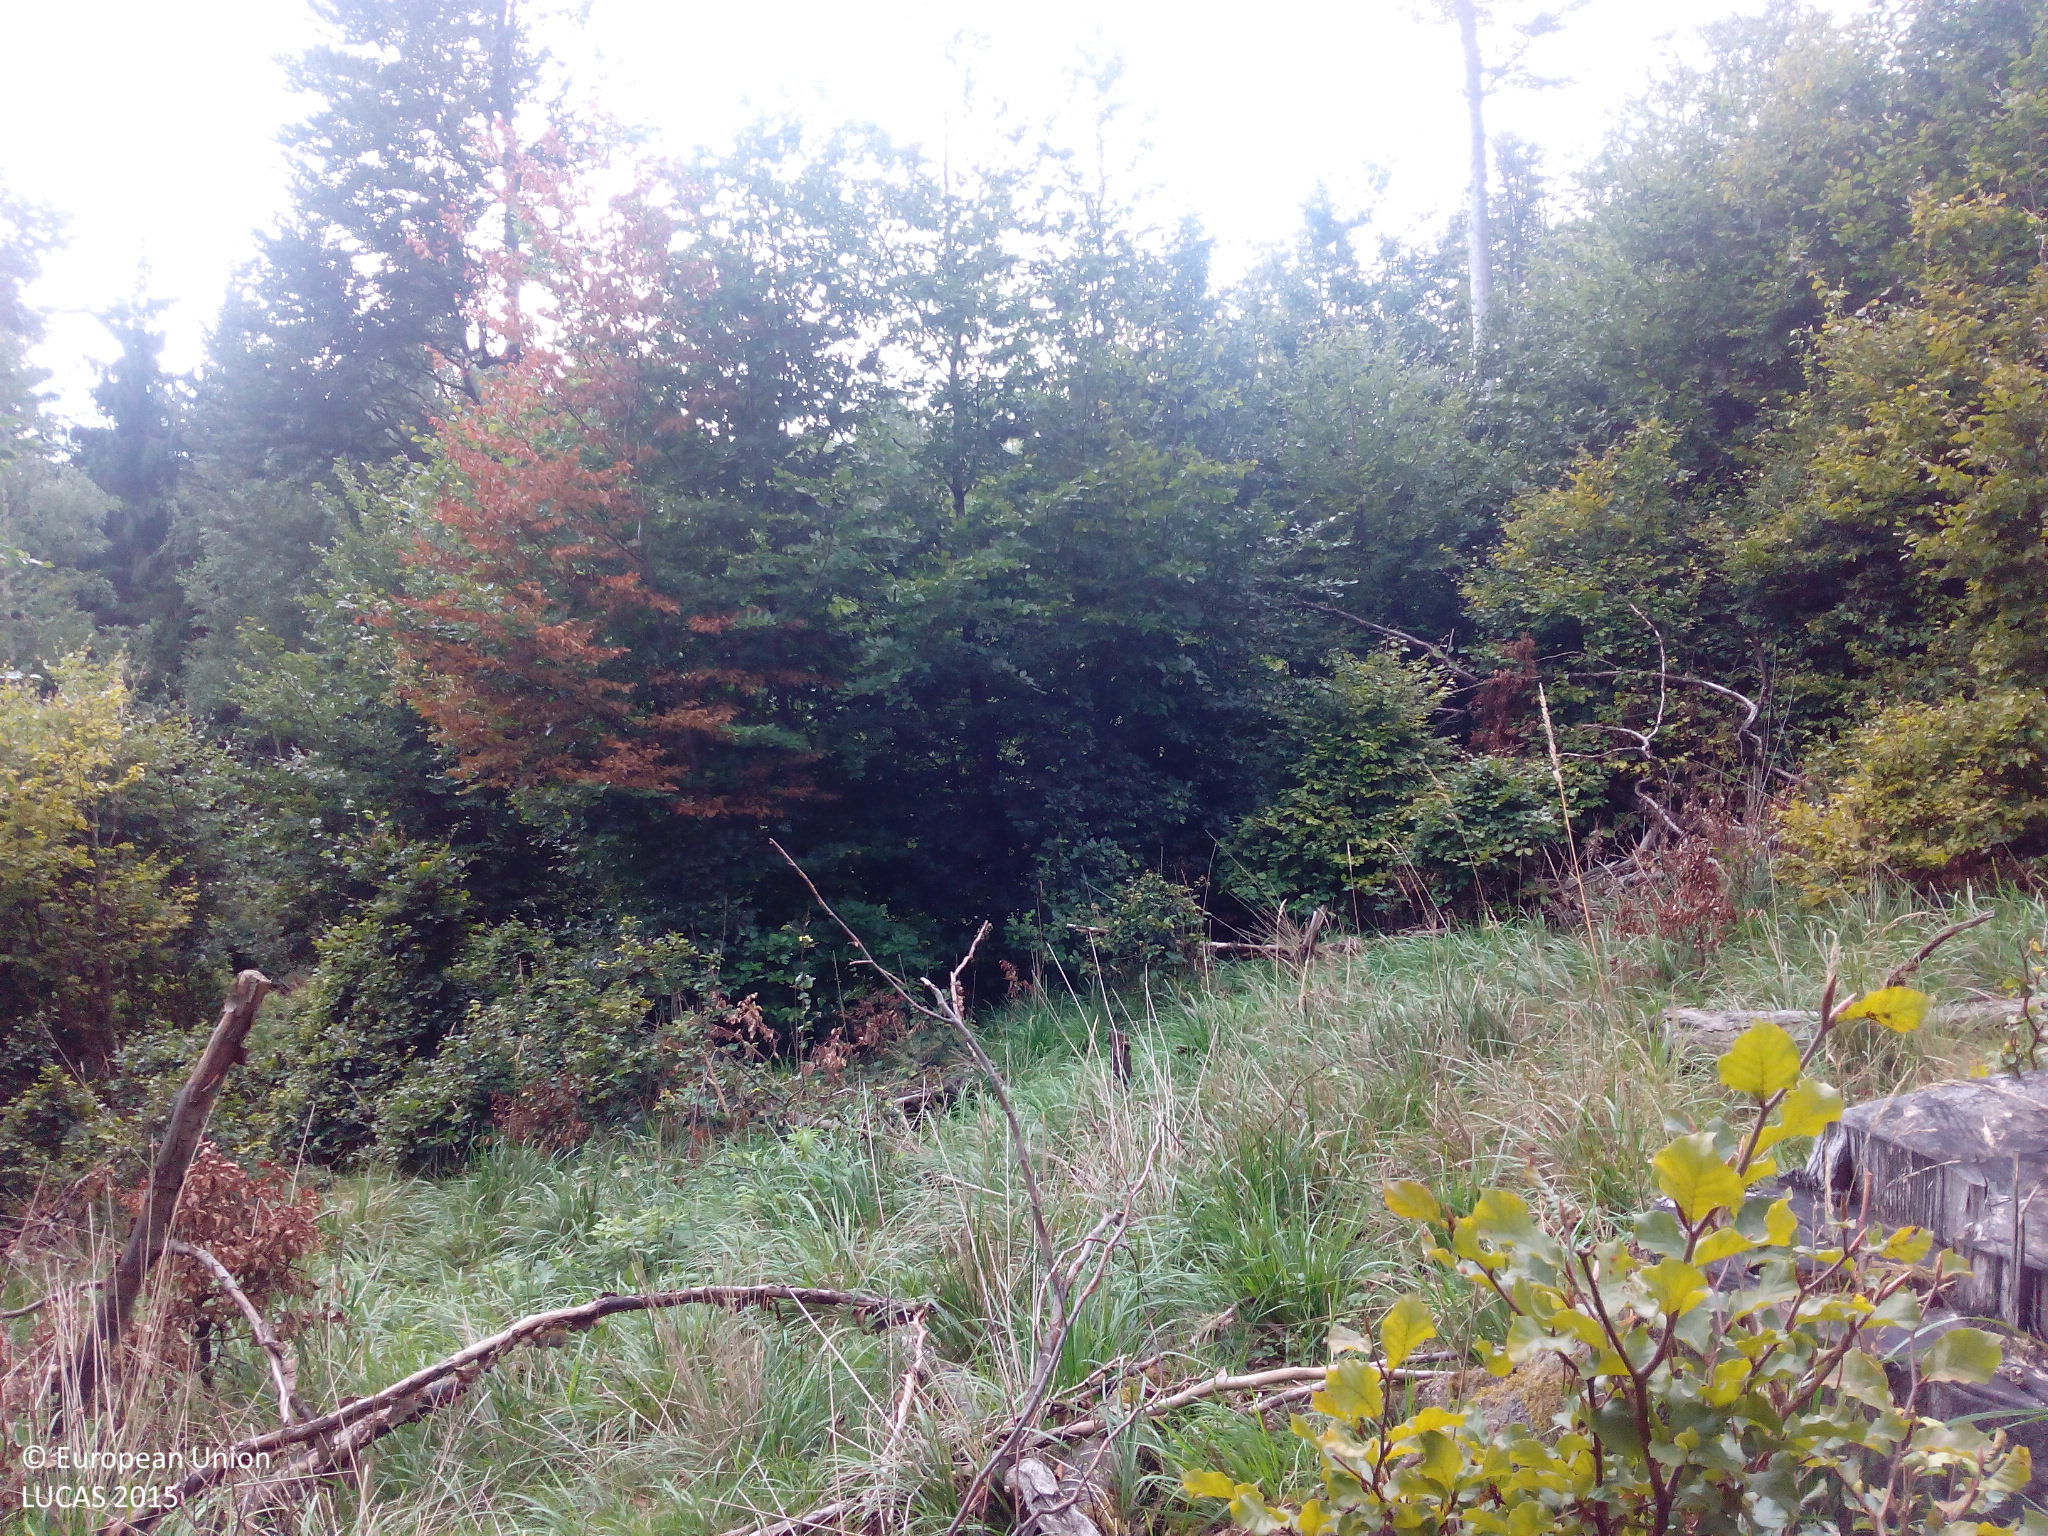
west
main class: Woodland
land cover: Broadleaved woodland
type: beech forest
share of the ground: 50 - 75 %
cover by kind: broadleaved forest trees 70 %, herbaceous plants 30 %
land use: Forestry
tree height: > 5 m
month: September
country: DE
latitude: 51.6005
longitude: 10.9670
